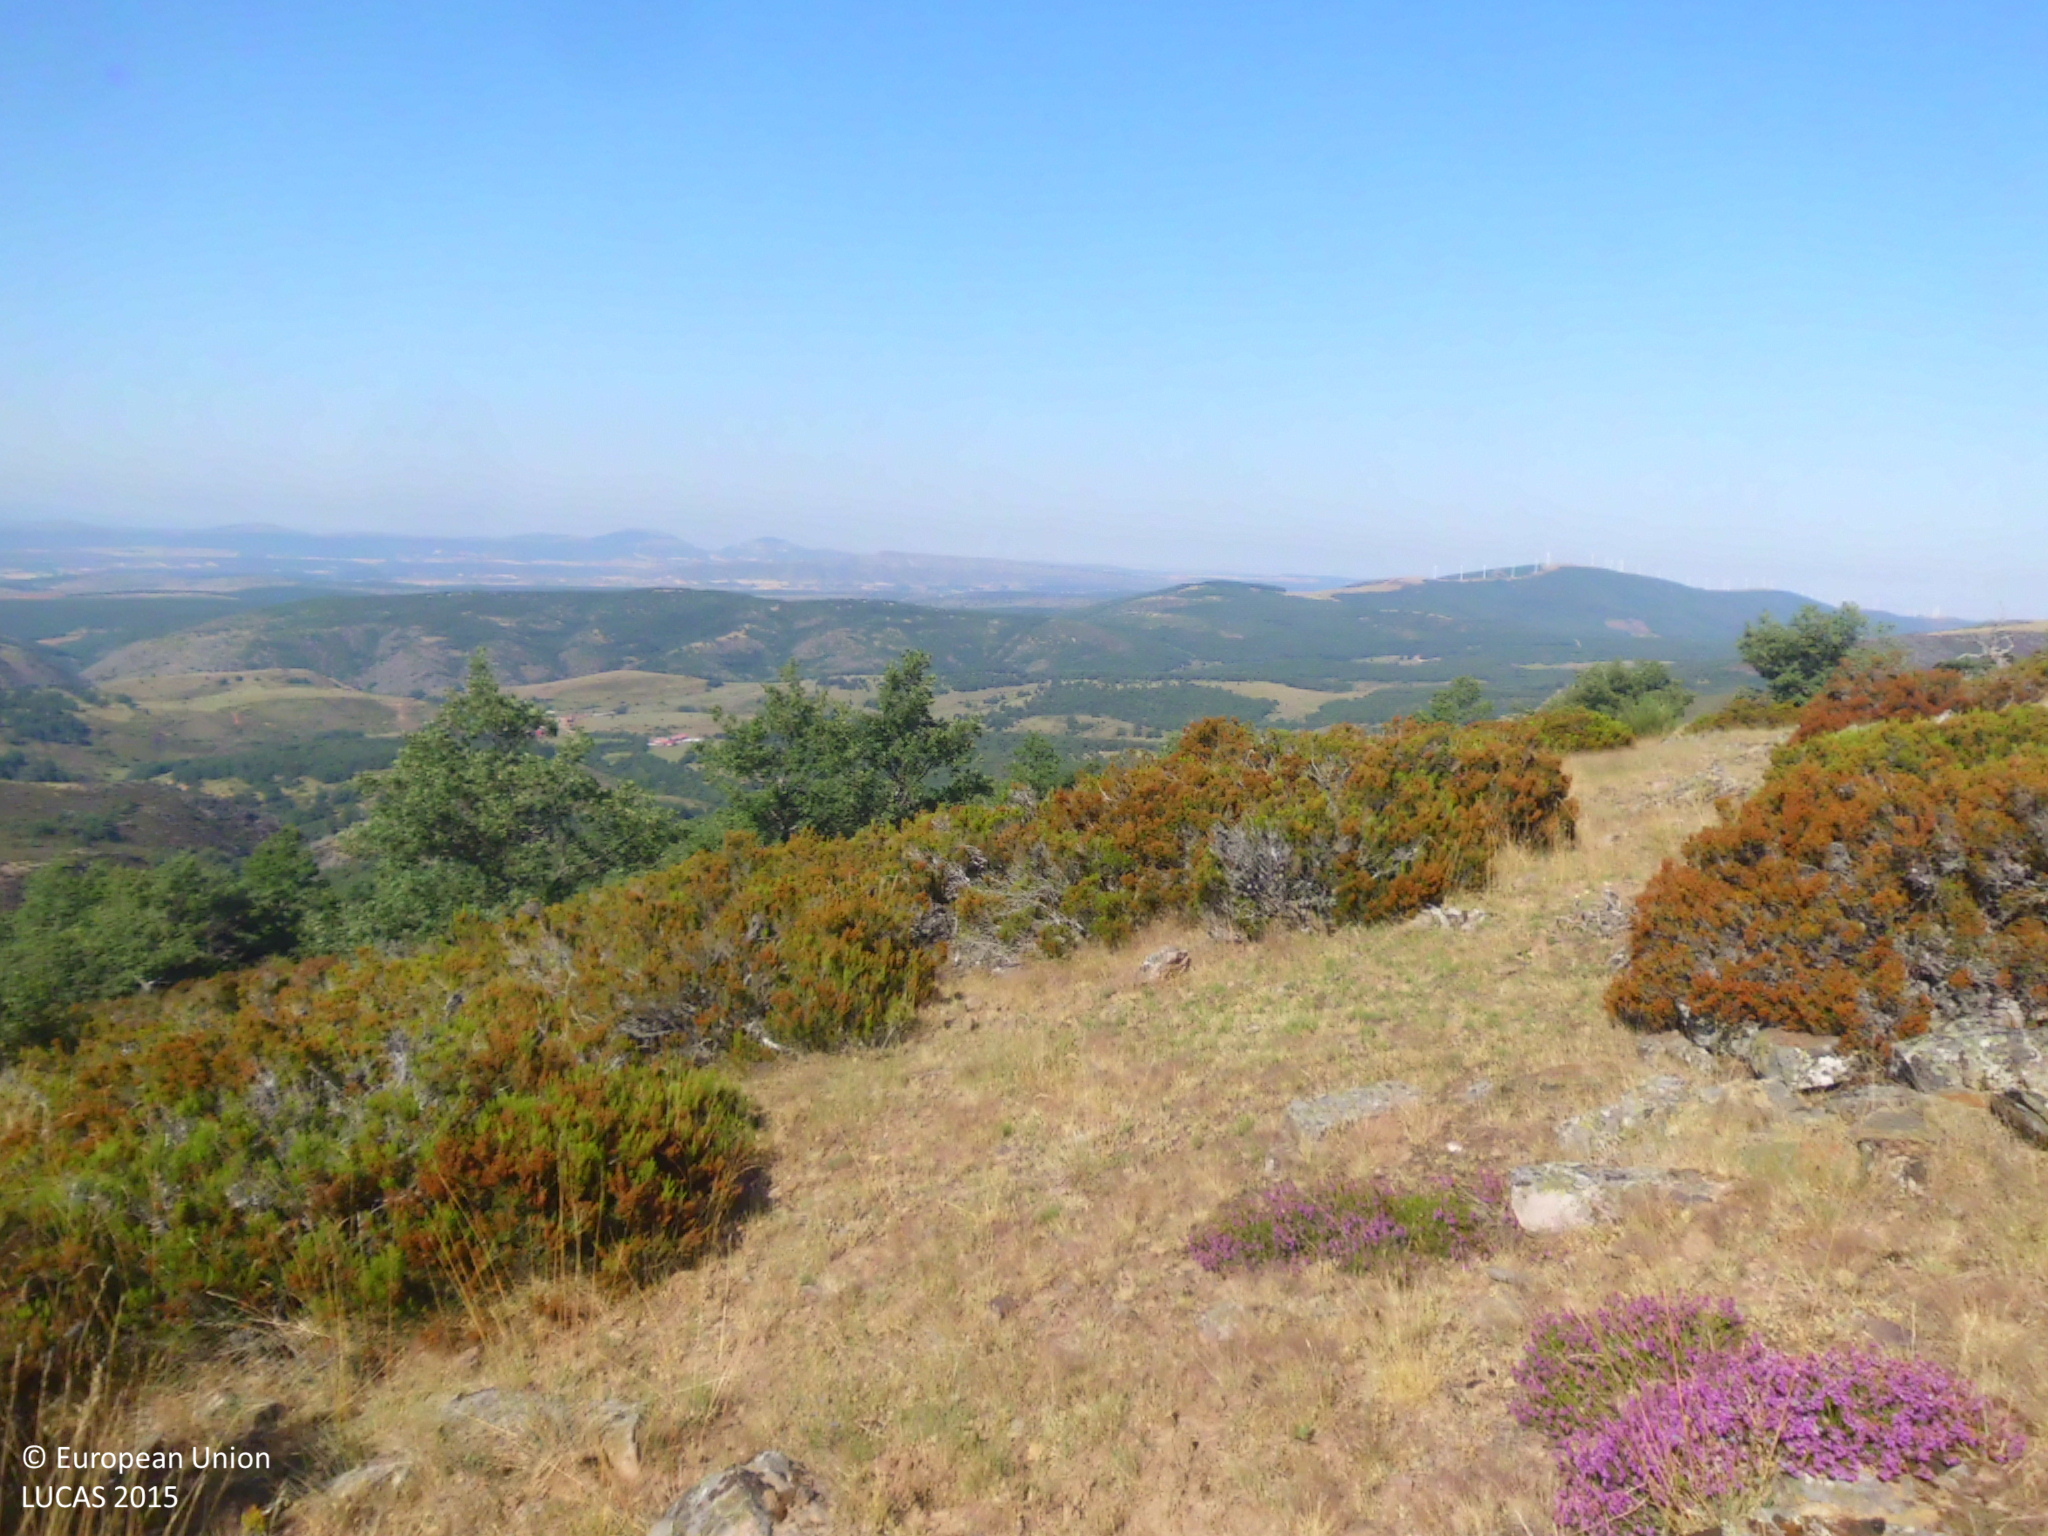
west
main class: Woodland
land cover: Broadleaved woodland
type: broadleaved evergreen forest
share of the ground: > 75 %
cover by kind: broadleaved forest trees 80 %, shrubs 20 %
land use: Forestry
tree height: > 5 m
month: July
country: ES
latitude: 42.1881
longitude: -3.3366
